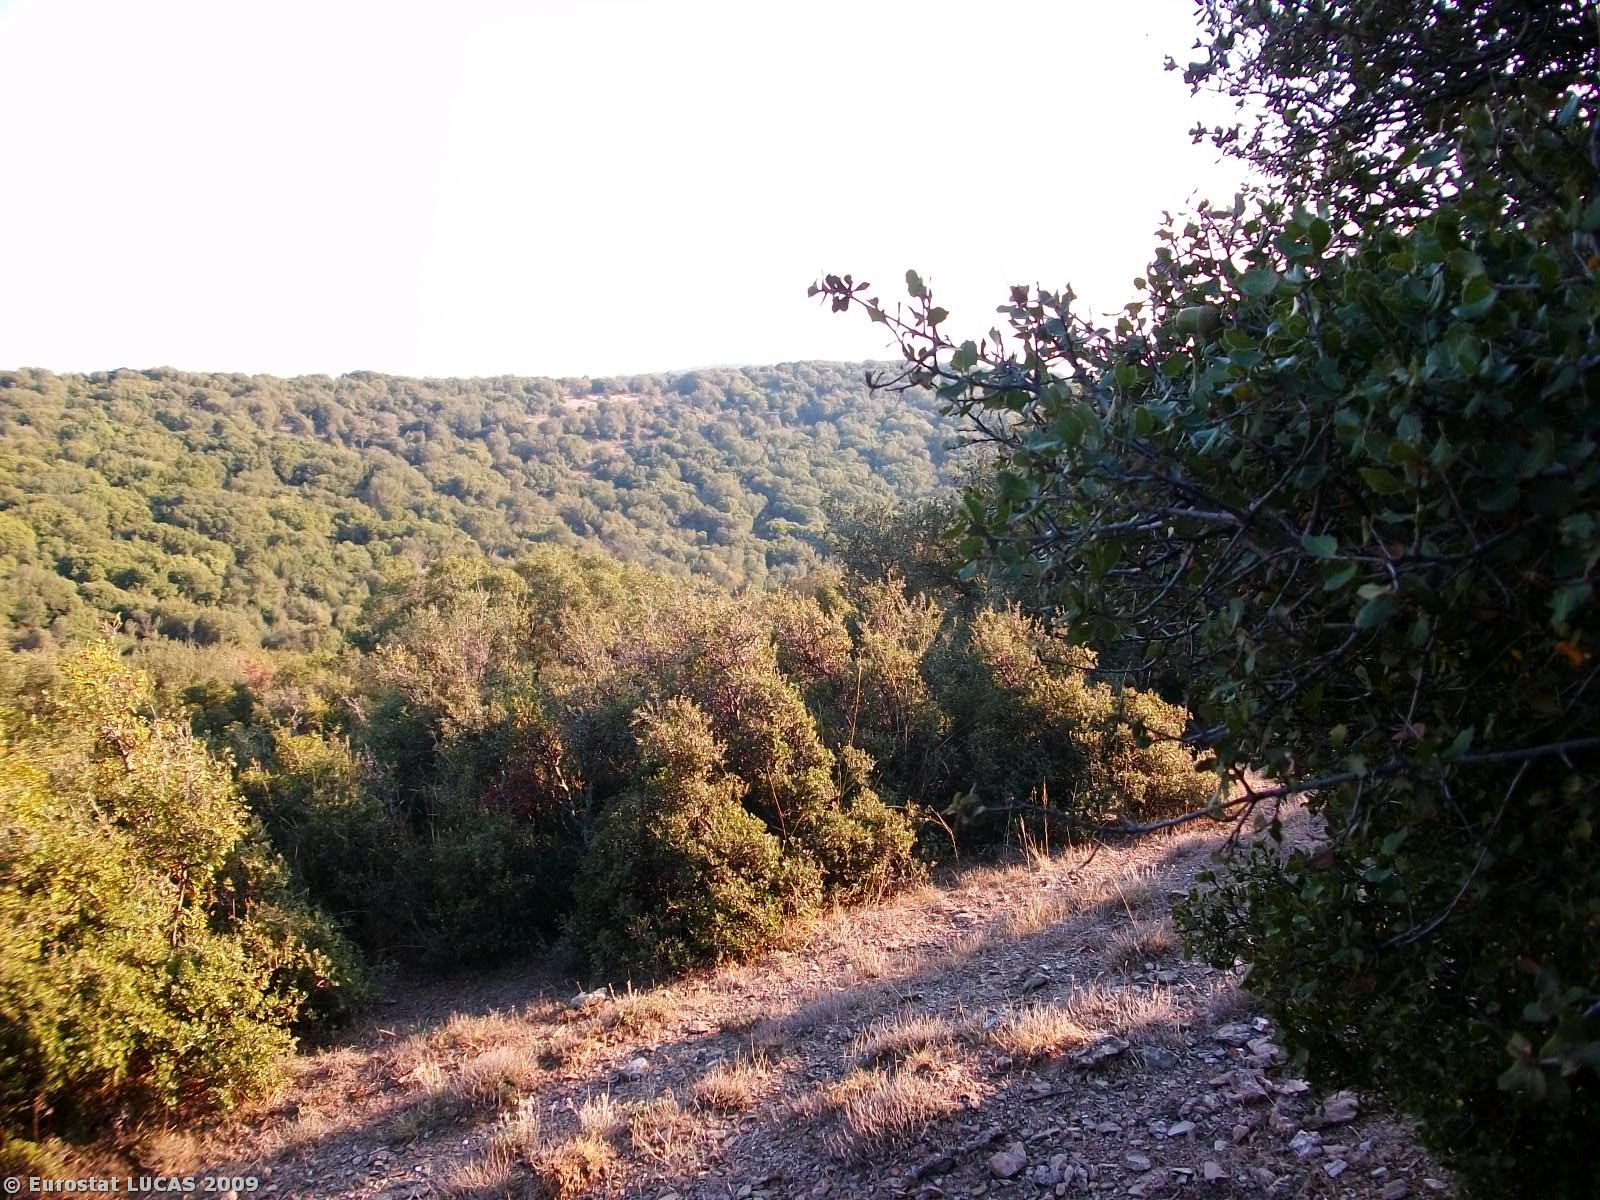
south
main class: Shrubland
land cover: Shrubland with sparse tree cover
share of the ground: > 75 %
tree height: < 5 m
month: October
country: GR
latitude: 40.8933
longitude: 25.7817
